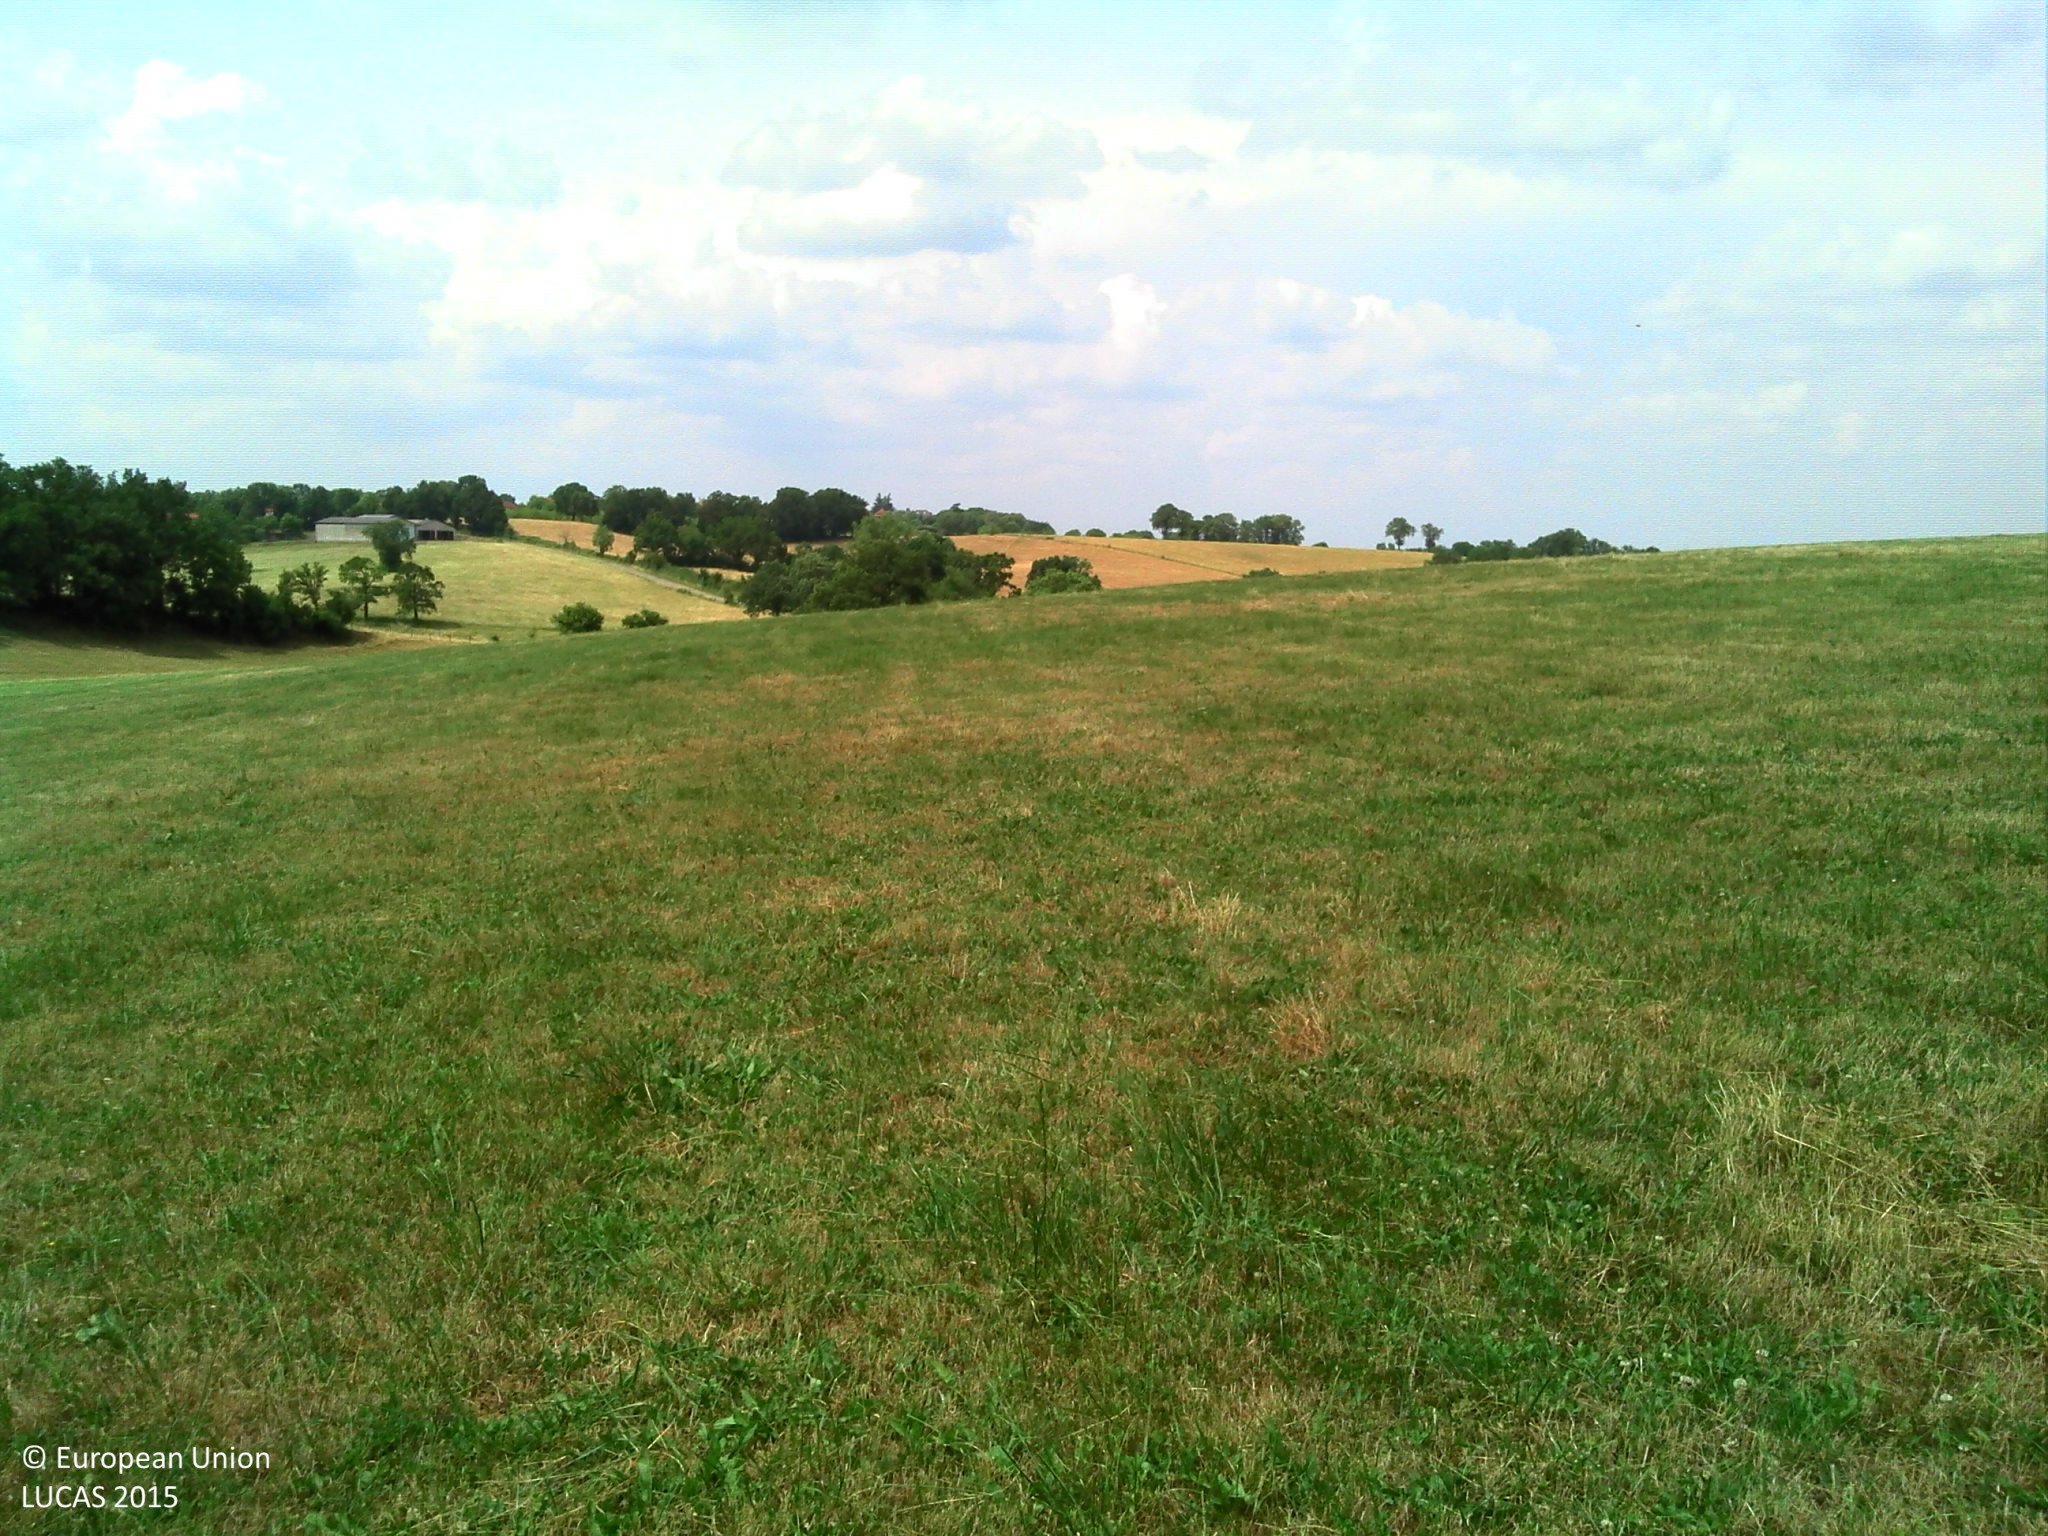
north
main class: Grassland
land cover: Grassland without tree/shrub cover
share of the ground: > 75 %
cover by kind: herbaceous plants 100 %
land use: Agriculture (excluding fallow land and kitchen gardens)
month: June
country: FR
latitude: 44.4358
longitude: 1.9476
